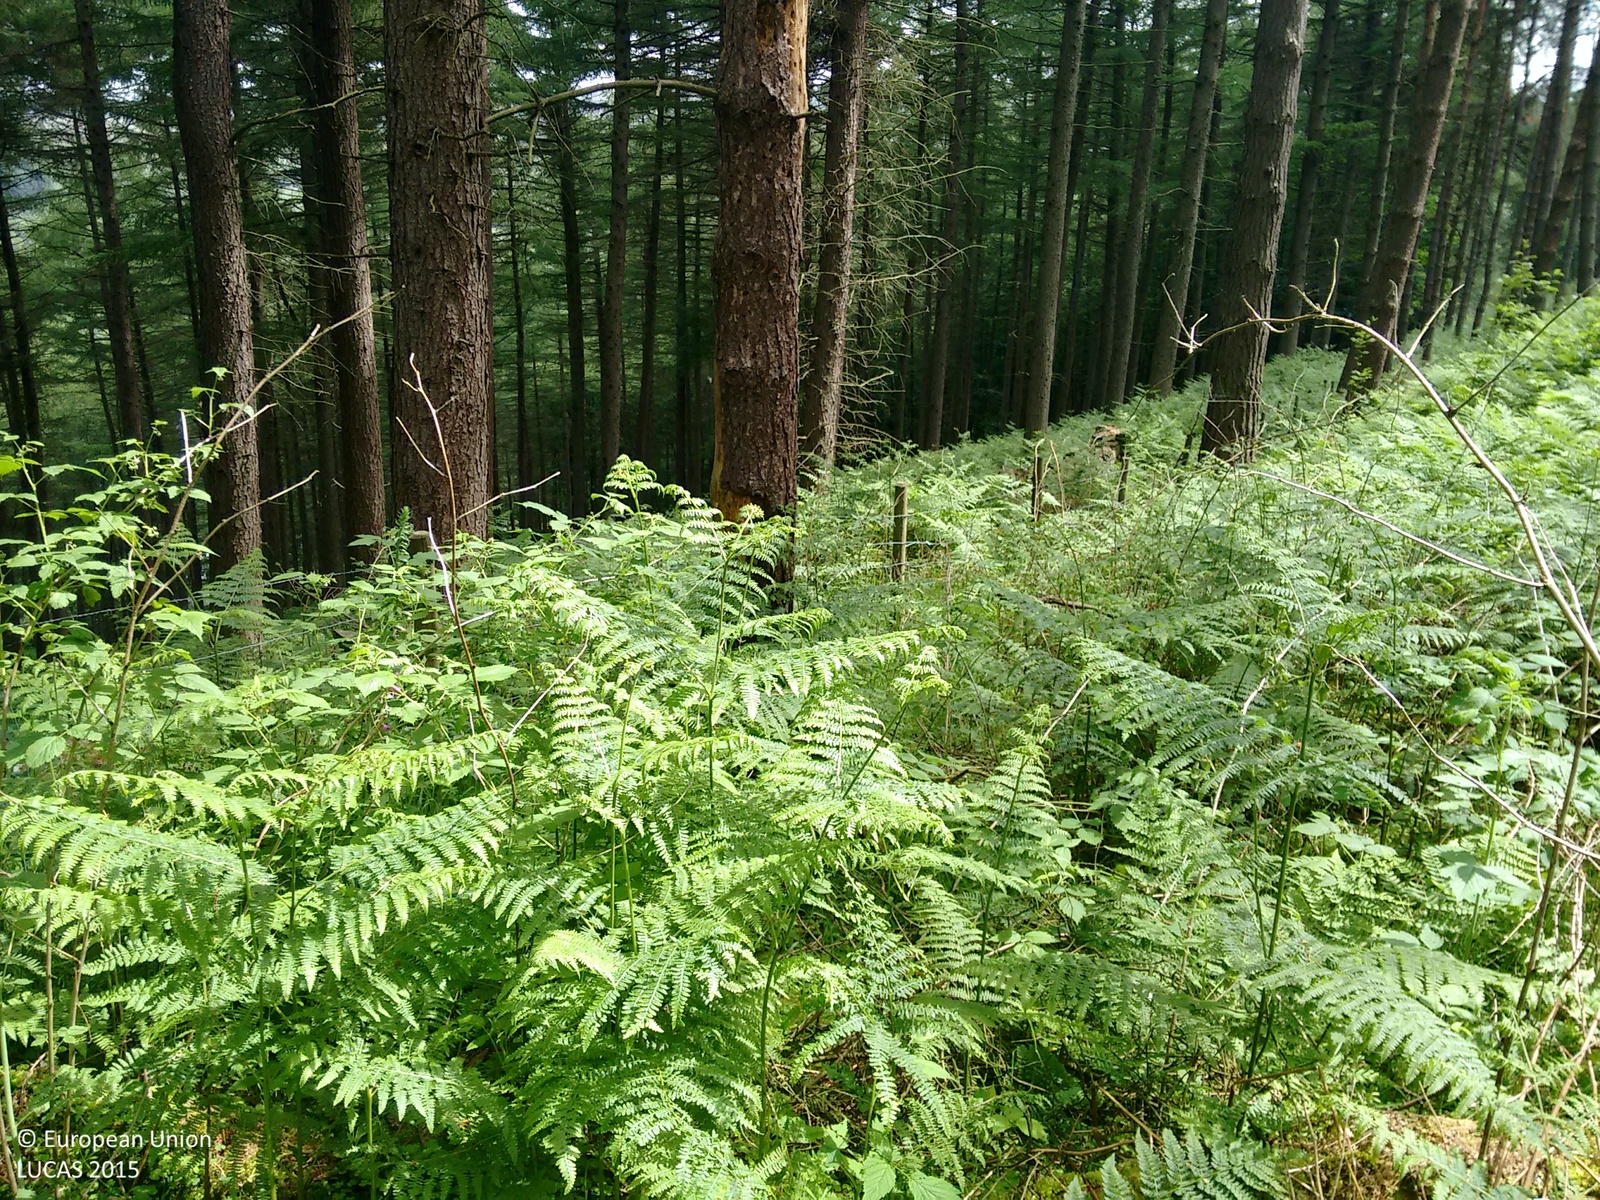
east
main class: Woodland
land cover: Spruce dominated coniferous woodland
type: exotic forest
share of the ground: > 75 %
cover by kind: coniferous forest trees 100 %
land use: Forestry
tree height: > 5 m
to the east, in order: Spruce dominated coniferous woodland; Fences; Dry stone walls; Spruce dominated coniferous woodland; Spruce dominated mixed woodland; Spruce dominated coniferous woodland
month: June
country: GB
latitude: 53.3922
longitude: -1.7376
